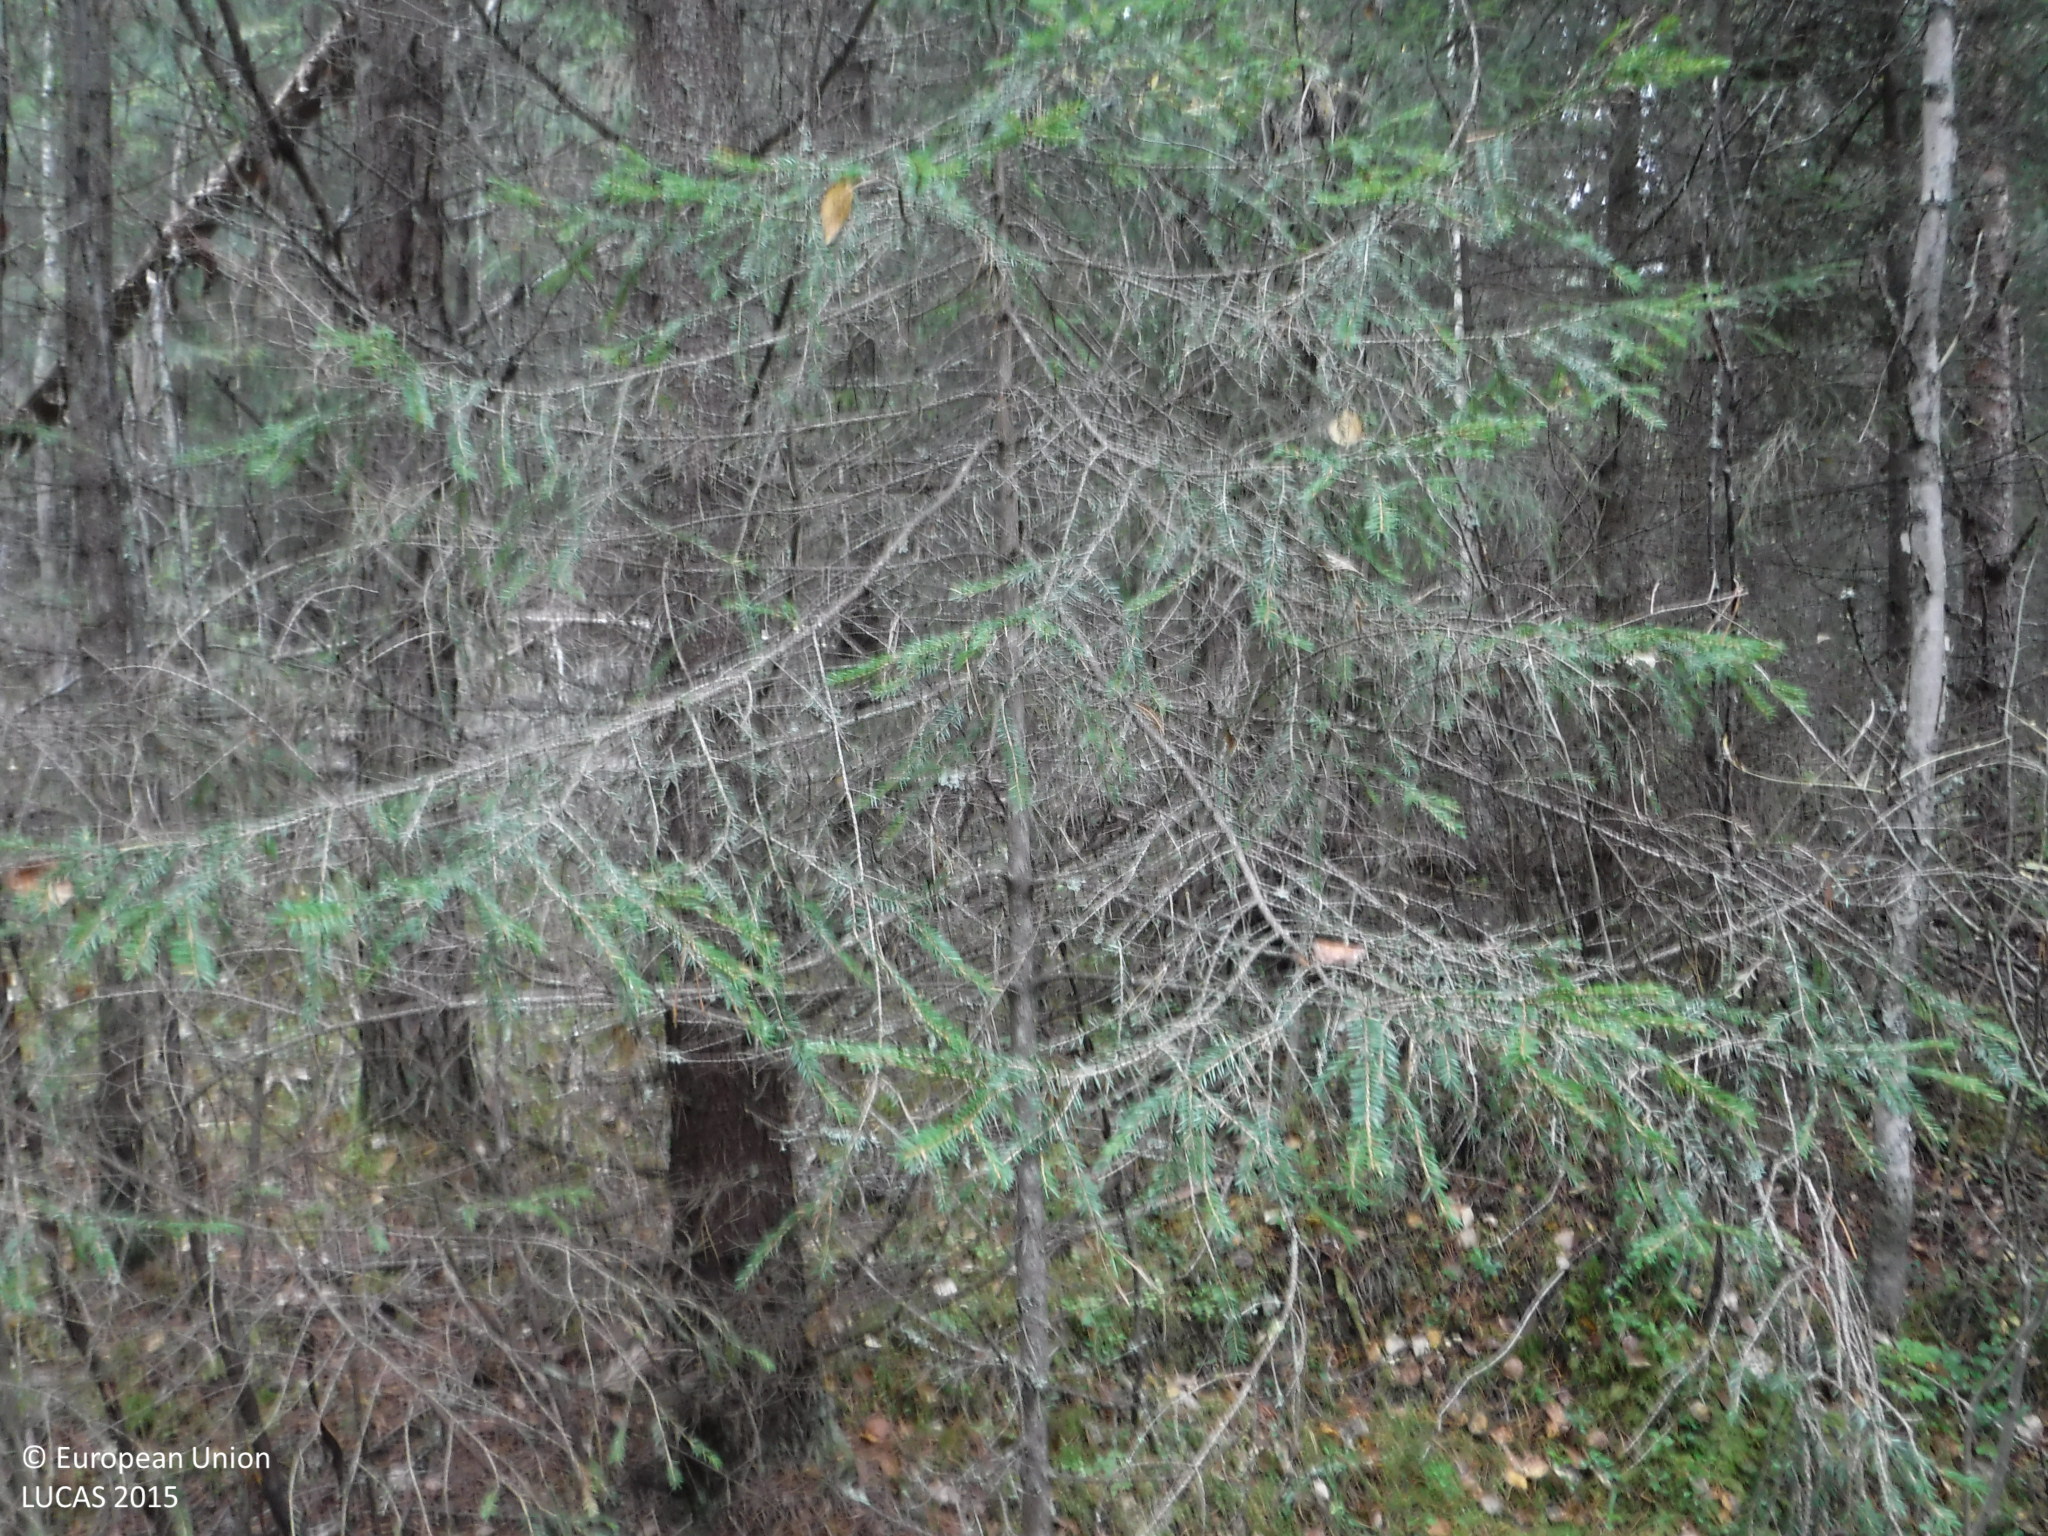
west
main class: Woodland
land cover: Other mixed woodland
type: boreal forest
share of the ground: > 75 %
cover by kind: coniferous forest trees 45 %, broadleaved forest trees 30 %, lichens and mosses 20 %, shrubs 5 %
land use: Forestry
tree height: > 5 m
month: September
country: FI
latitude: 62.0919
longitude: 23.3049
